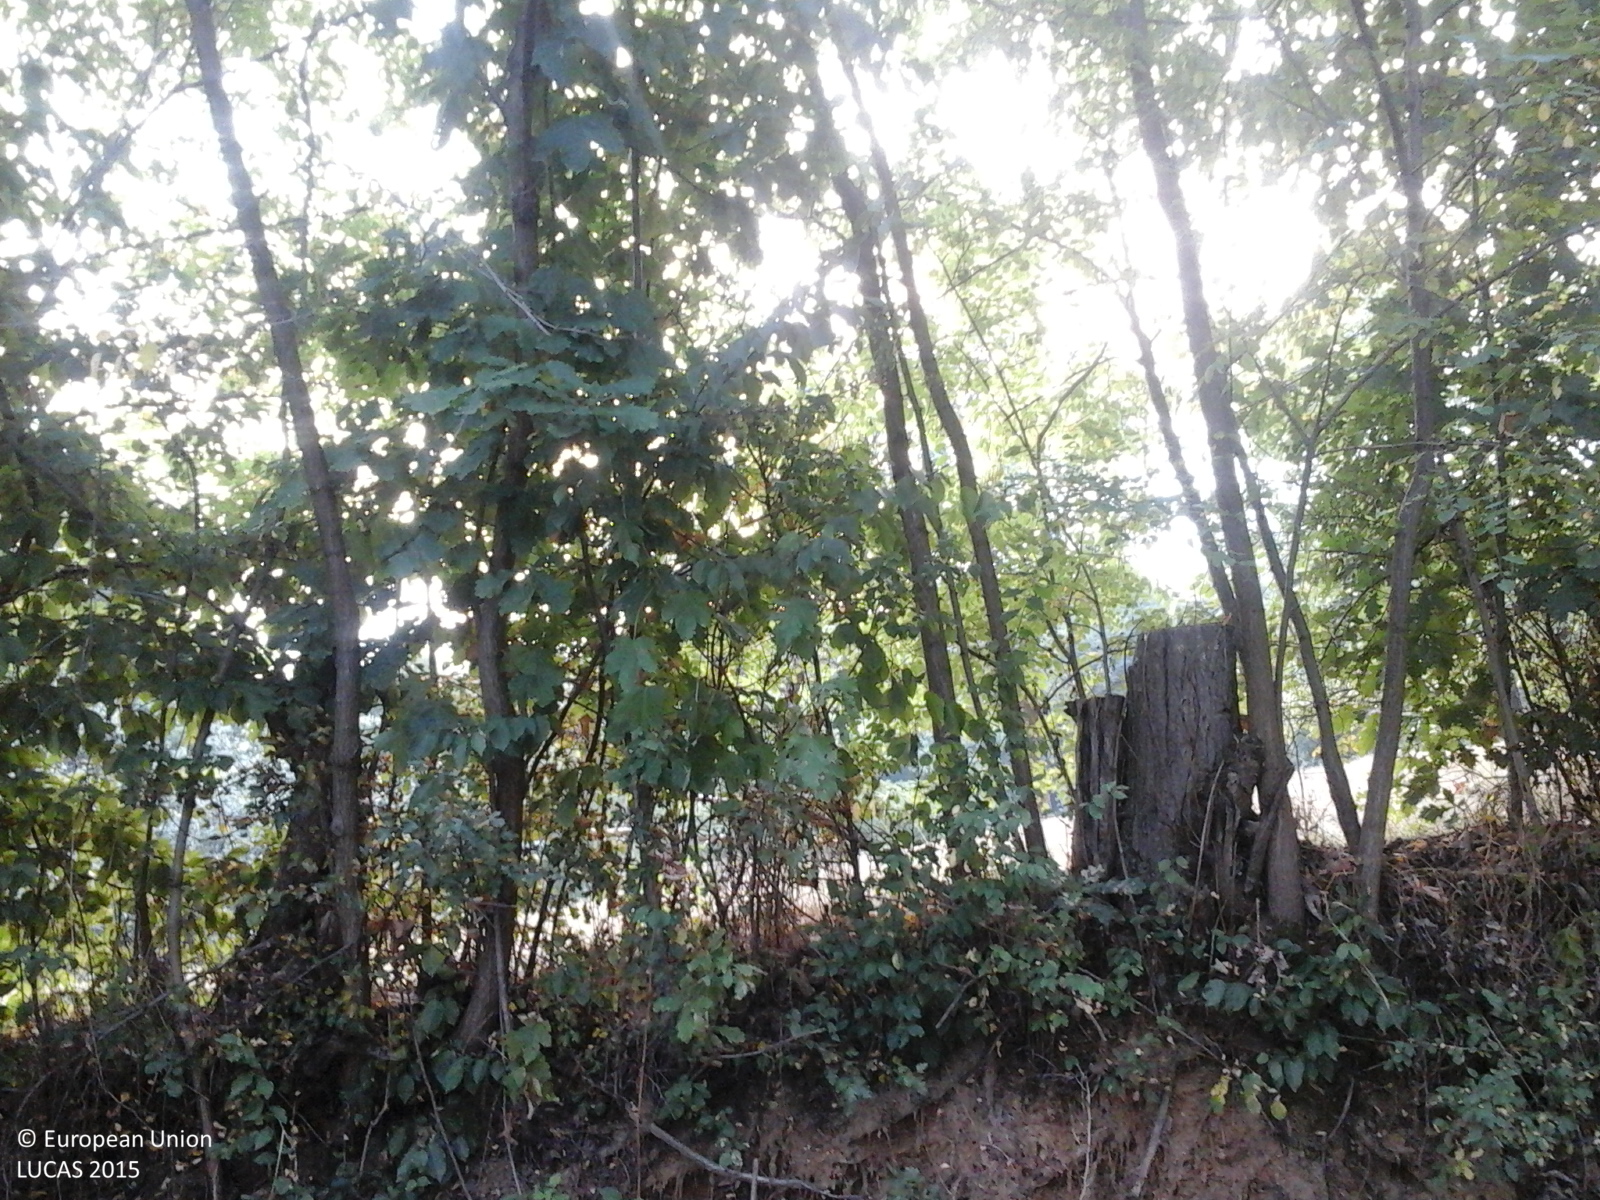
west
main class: Cropland
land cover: Other fruit trees and berries
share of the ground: 10 - 25 %
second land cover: Grassland without tree/shrub cover
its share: > 75 %
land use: Agriculture (excluding fallow land and kitchen gardens)
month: September
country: RO
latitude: 47.7323
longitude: 24.3729
